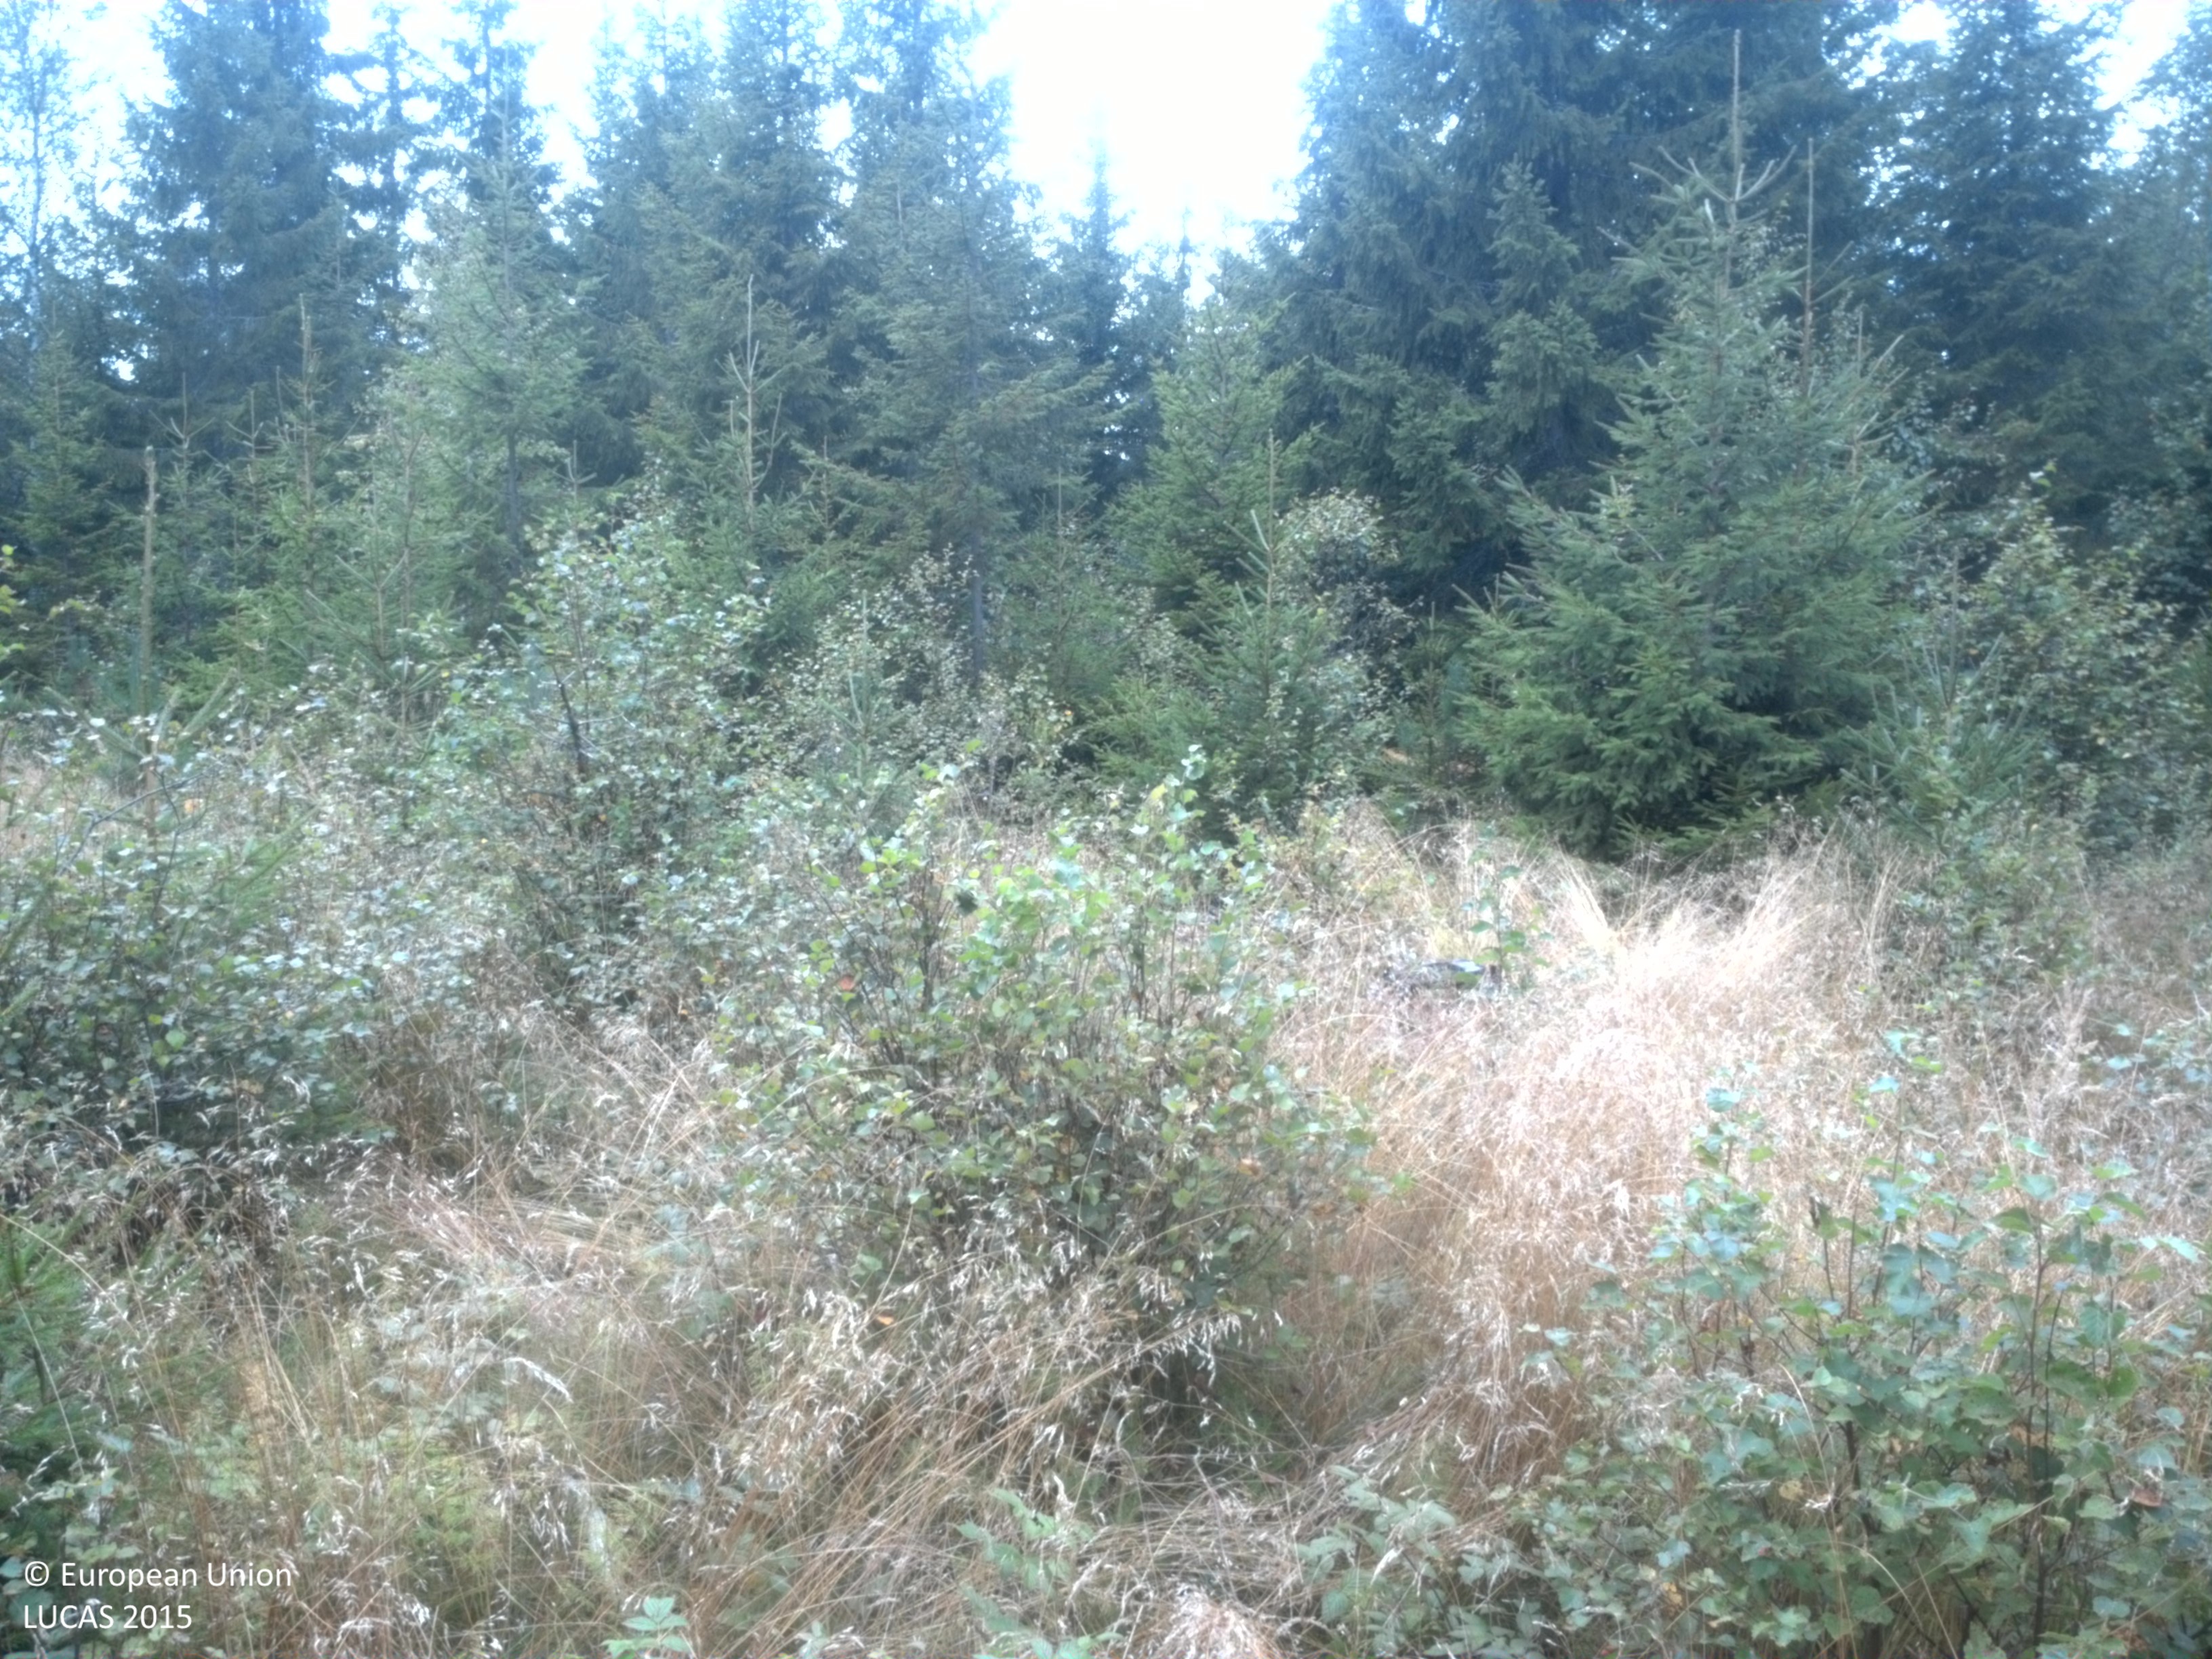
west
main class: Woodland
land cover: Spruce dominated mixed woodland
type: boreal forest
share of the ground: > 75 %
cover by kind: broadleaved forest trees 55 %, coniferous forest trees 20 %, herbaceous plants 20 %, shrubs 5 %
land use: Forestry
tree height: < 5 m
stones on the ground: < 10 %
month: August
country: SE
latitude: 59.6853
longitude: 15.7277
